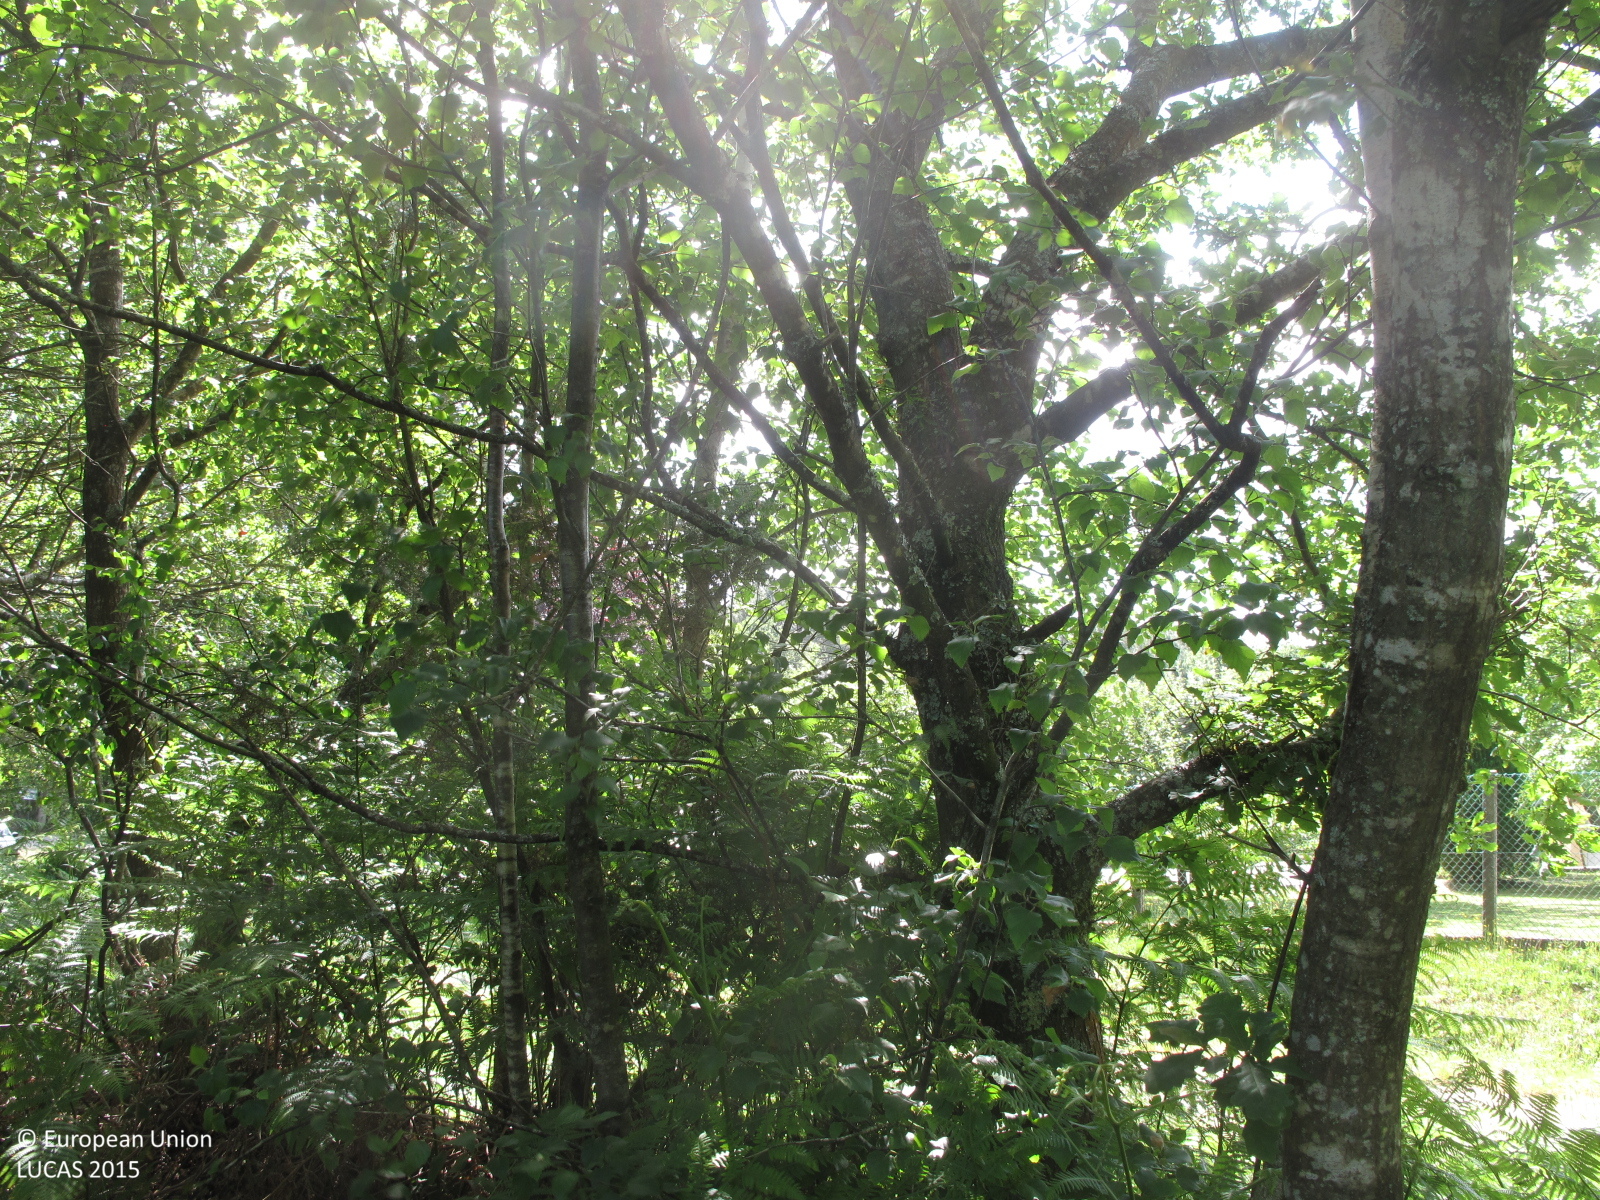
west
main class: Woodland
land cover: Broadleaved woodland
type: acidophilous oak and oak-birch forest
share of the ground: 25 - 50 %
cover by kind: herbaceous plants 60 %, broadleaved forest trees 30 %, shrubs 10 %
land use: Forestry
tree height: > 5 m
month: June
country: ES
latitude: 42.9504
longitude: -8.4767
